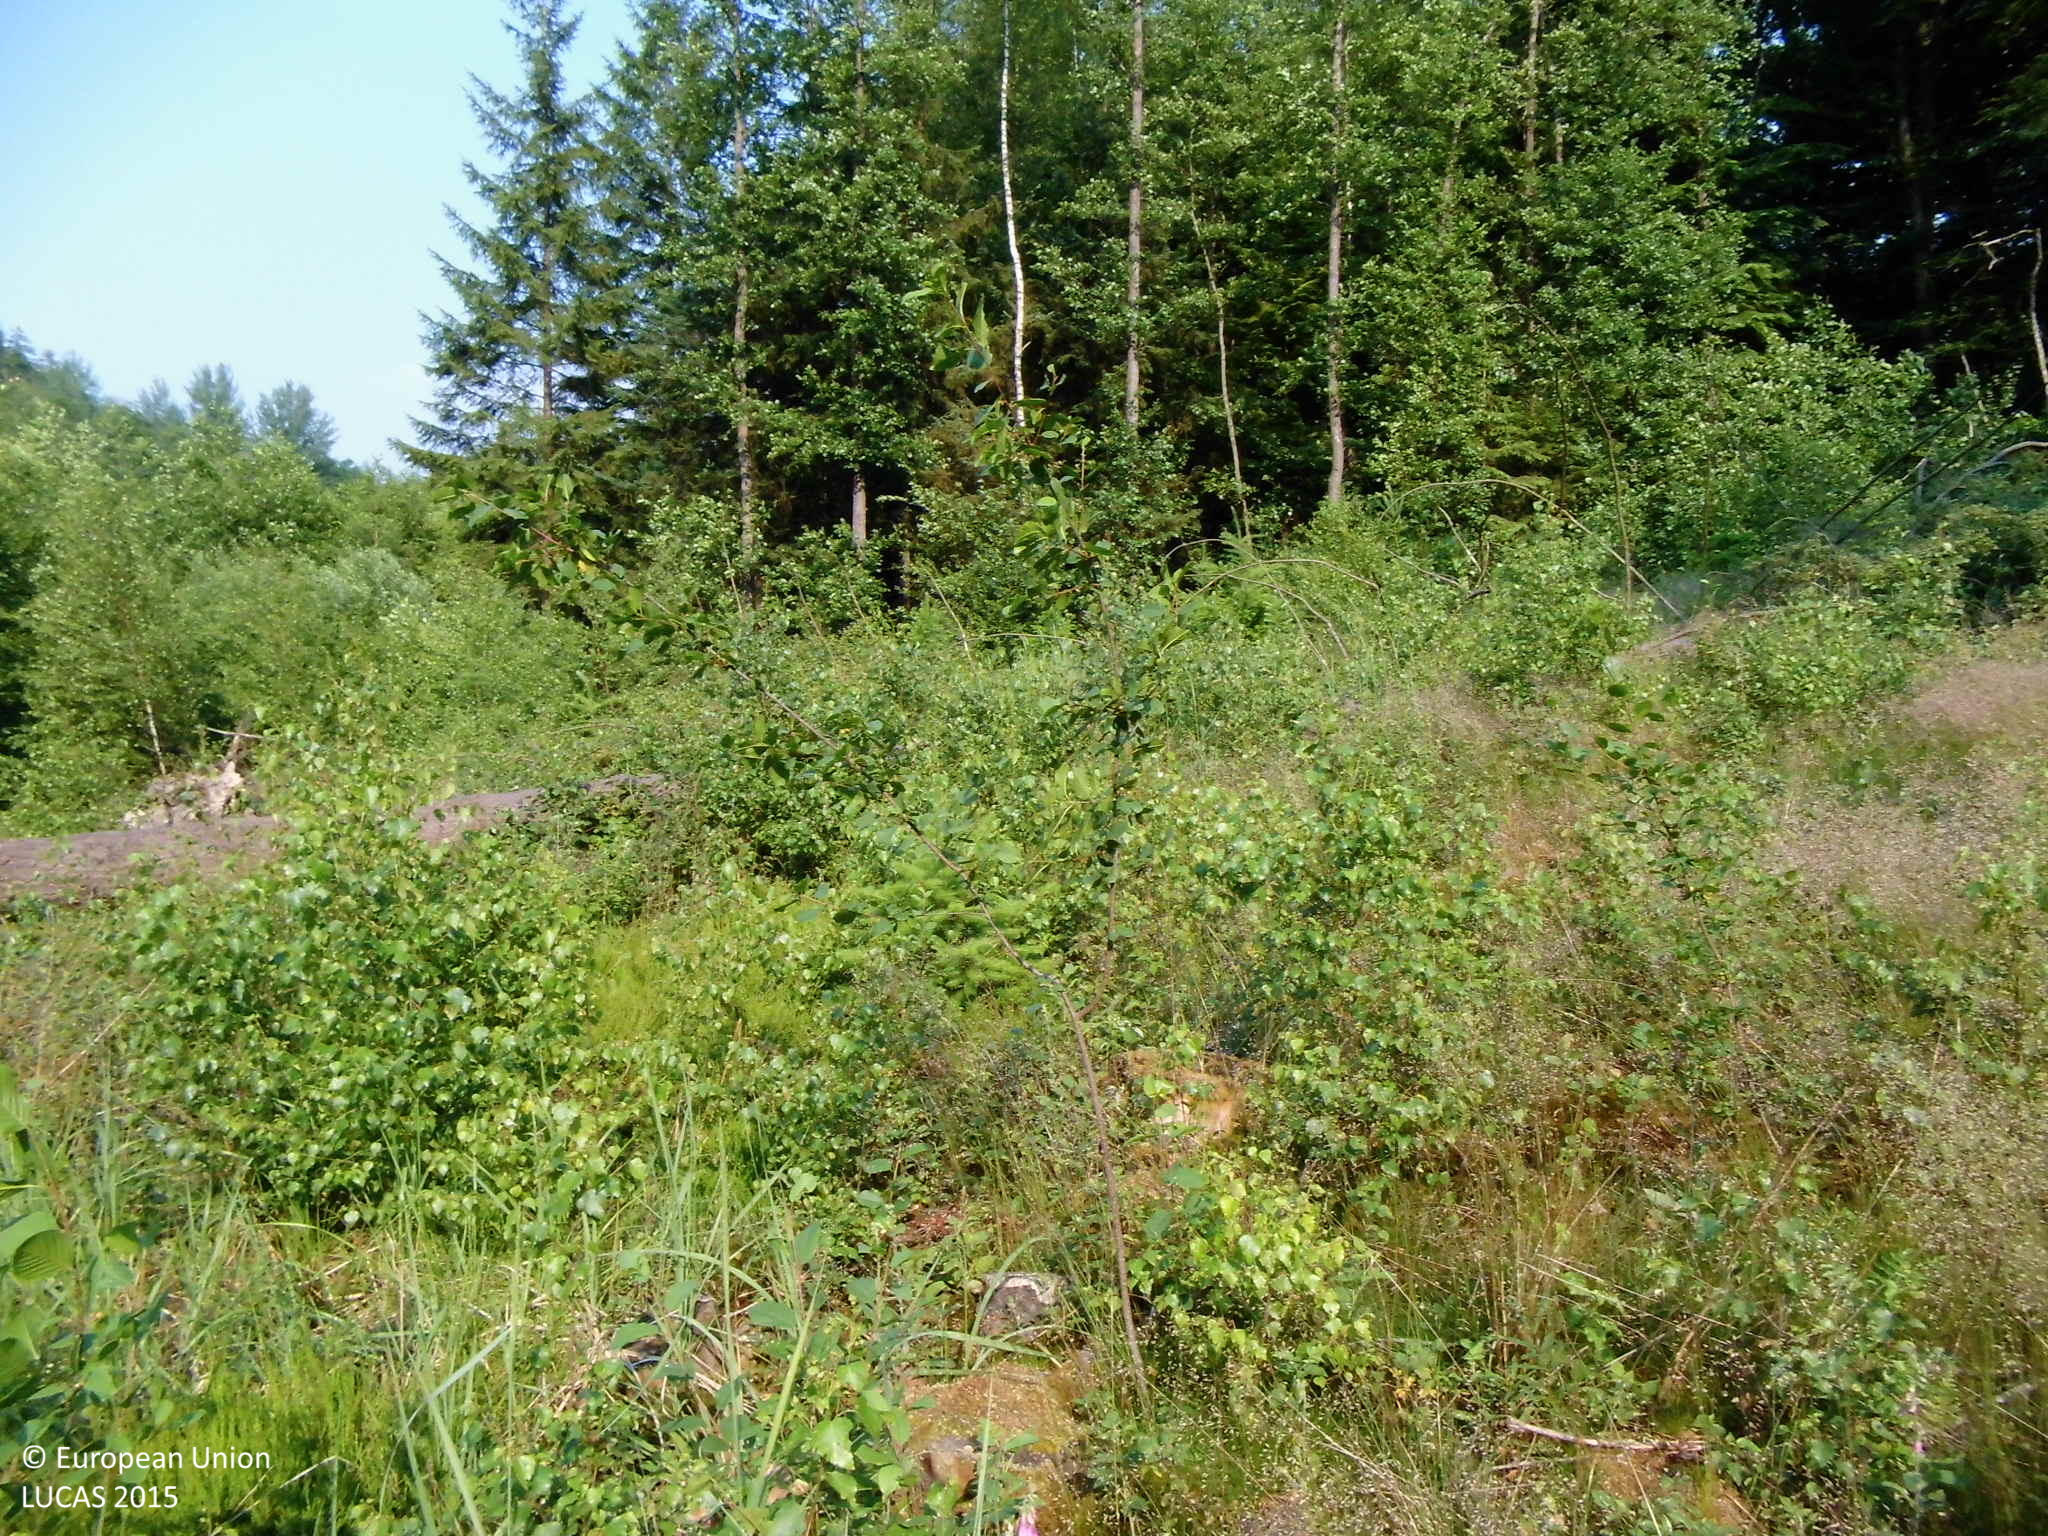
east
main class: Shrubland
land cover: Shrubland with sparse tree cover
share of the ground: 50 - 75 %
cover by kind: shrubs 50 %, herbaceous plants 35 %, broadleaved forest trees 5 %, lichens and mosses 5 %, unconsolidated bare surface 5 %
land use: Forestry
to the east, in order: Shrubland with sparse tree cover; Broadleaved woodland; Rivers and streams; Spruce dominated mixed woodland; Rivers and streams; Broadleaved woodland; Fences; Spruce dominated mixed woodland; Fences; Spruce dominated mixed woodland; Grass margins; Tracks; Grass margins; Ditches and canals; Broadleaved woodland
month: July
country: DE
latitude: 51.3538
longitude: 8.0044
